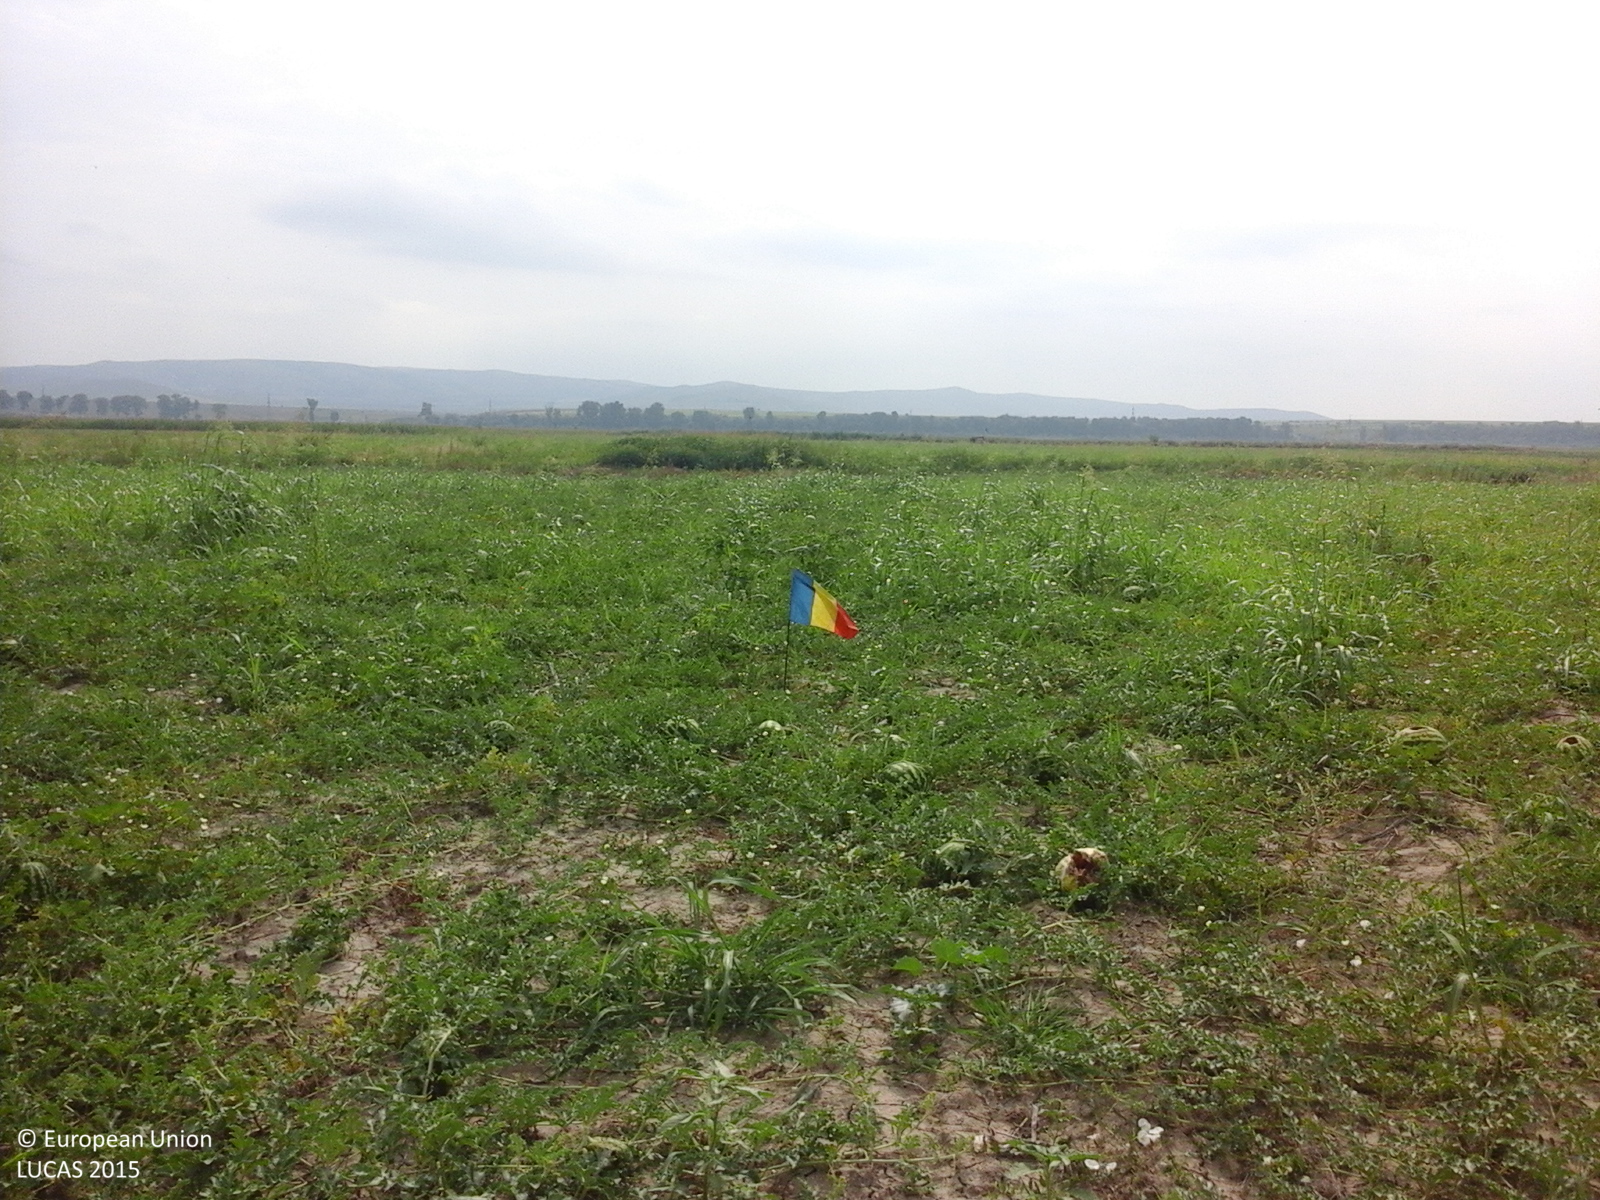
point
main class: Cropland
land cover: Other fresh vegetables
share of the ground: > 75 %
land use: Agriculture (excluding fallow land and kitchen gardens)
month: July
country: RO
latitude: 44.9470
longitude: 28.1524
